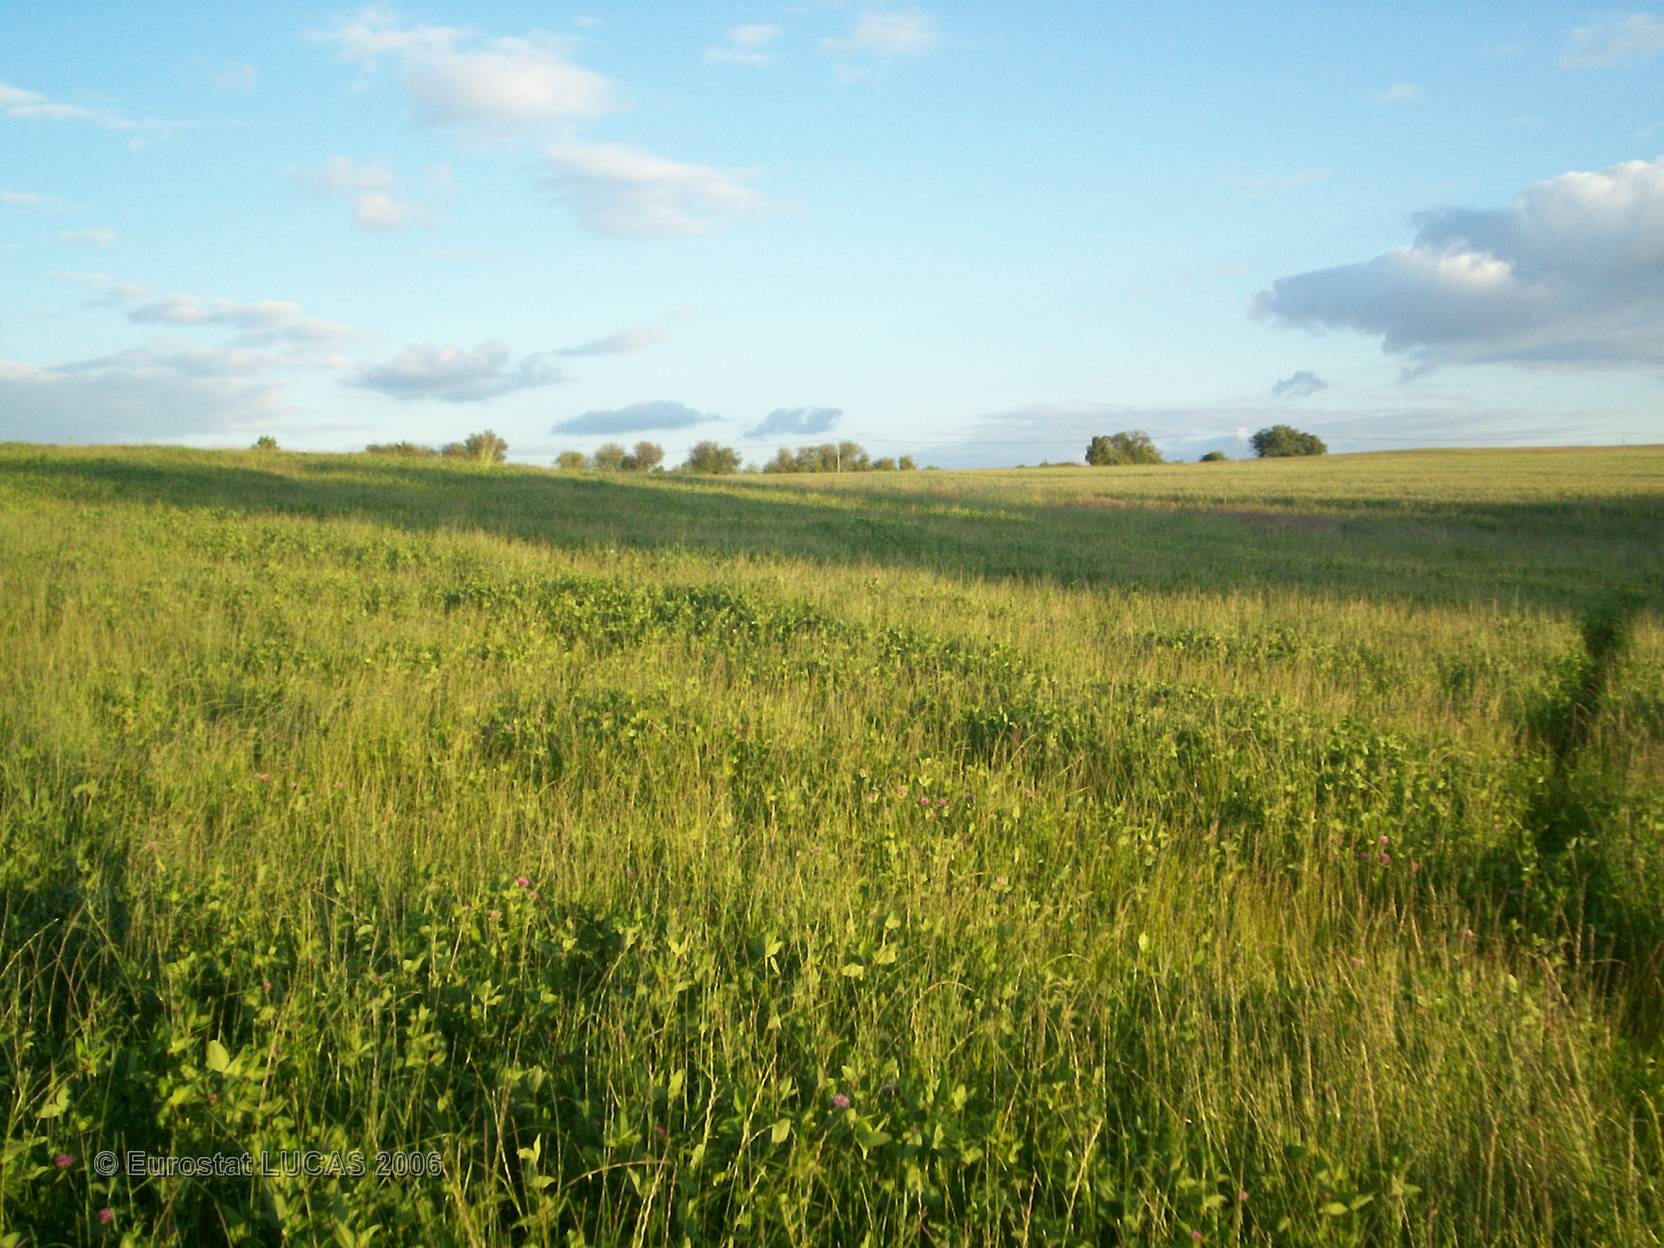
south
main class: Cropland
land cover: Other leguminous and mixtures for fodder
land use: Agriculture (excluding fallow land and kitchen gardens)
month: June
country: FR
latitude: 46.0762
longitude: 3.1330
